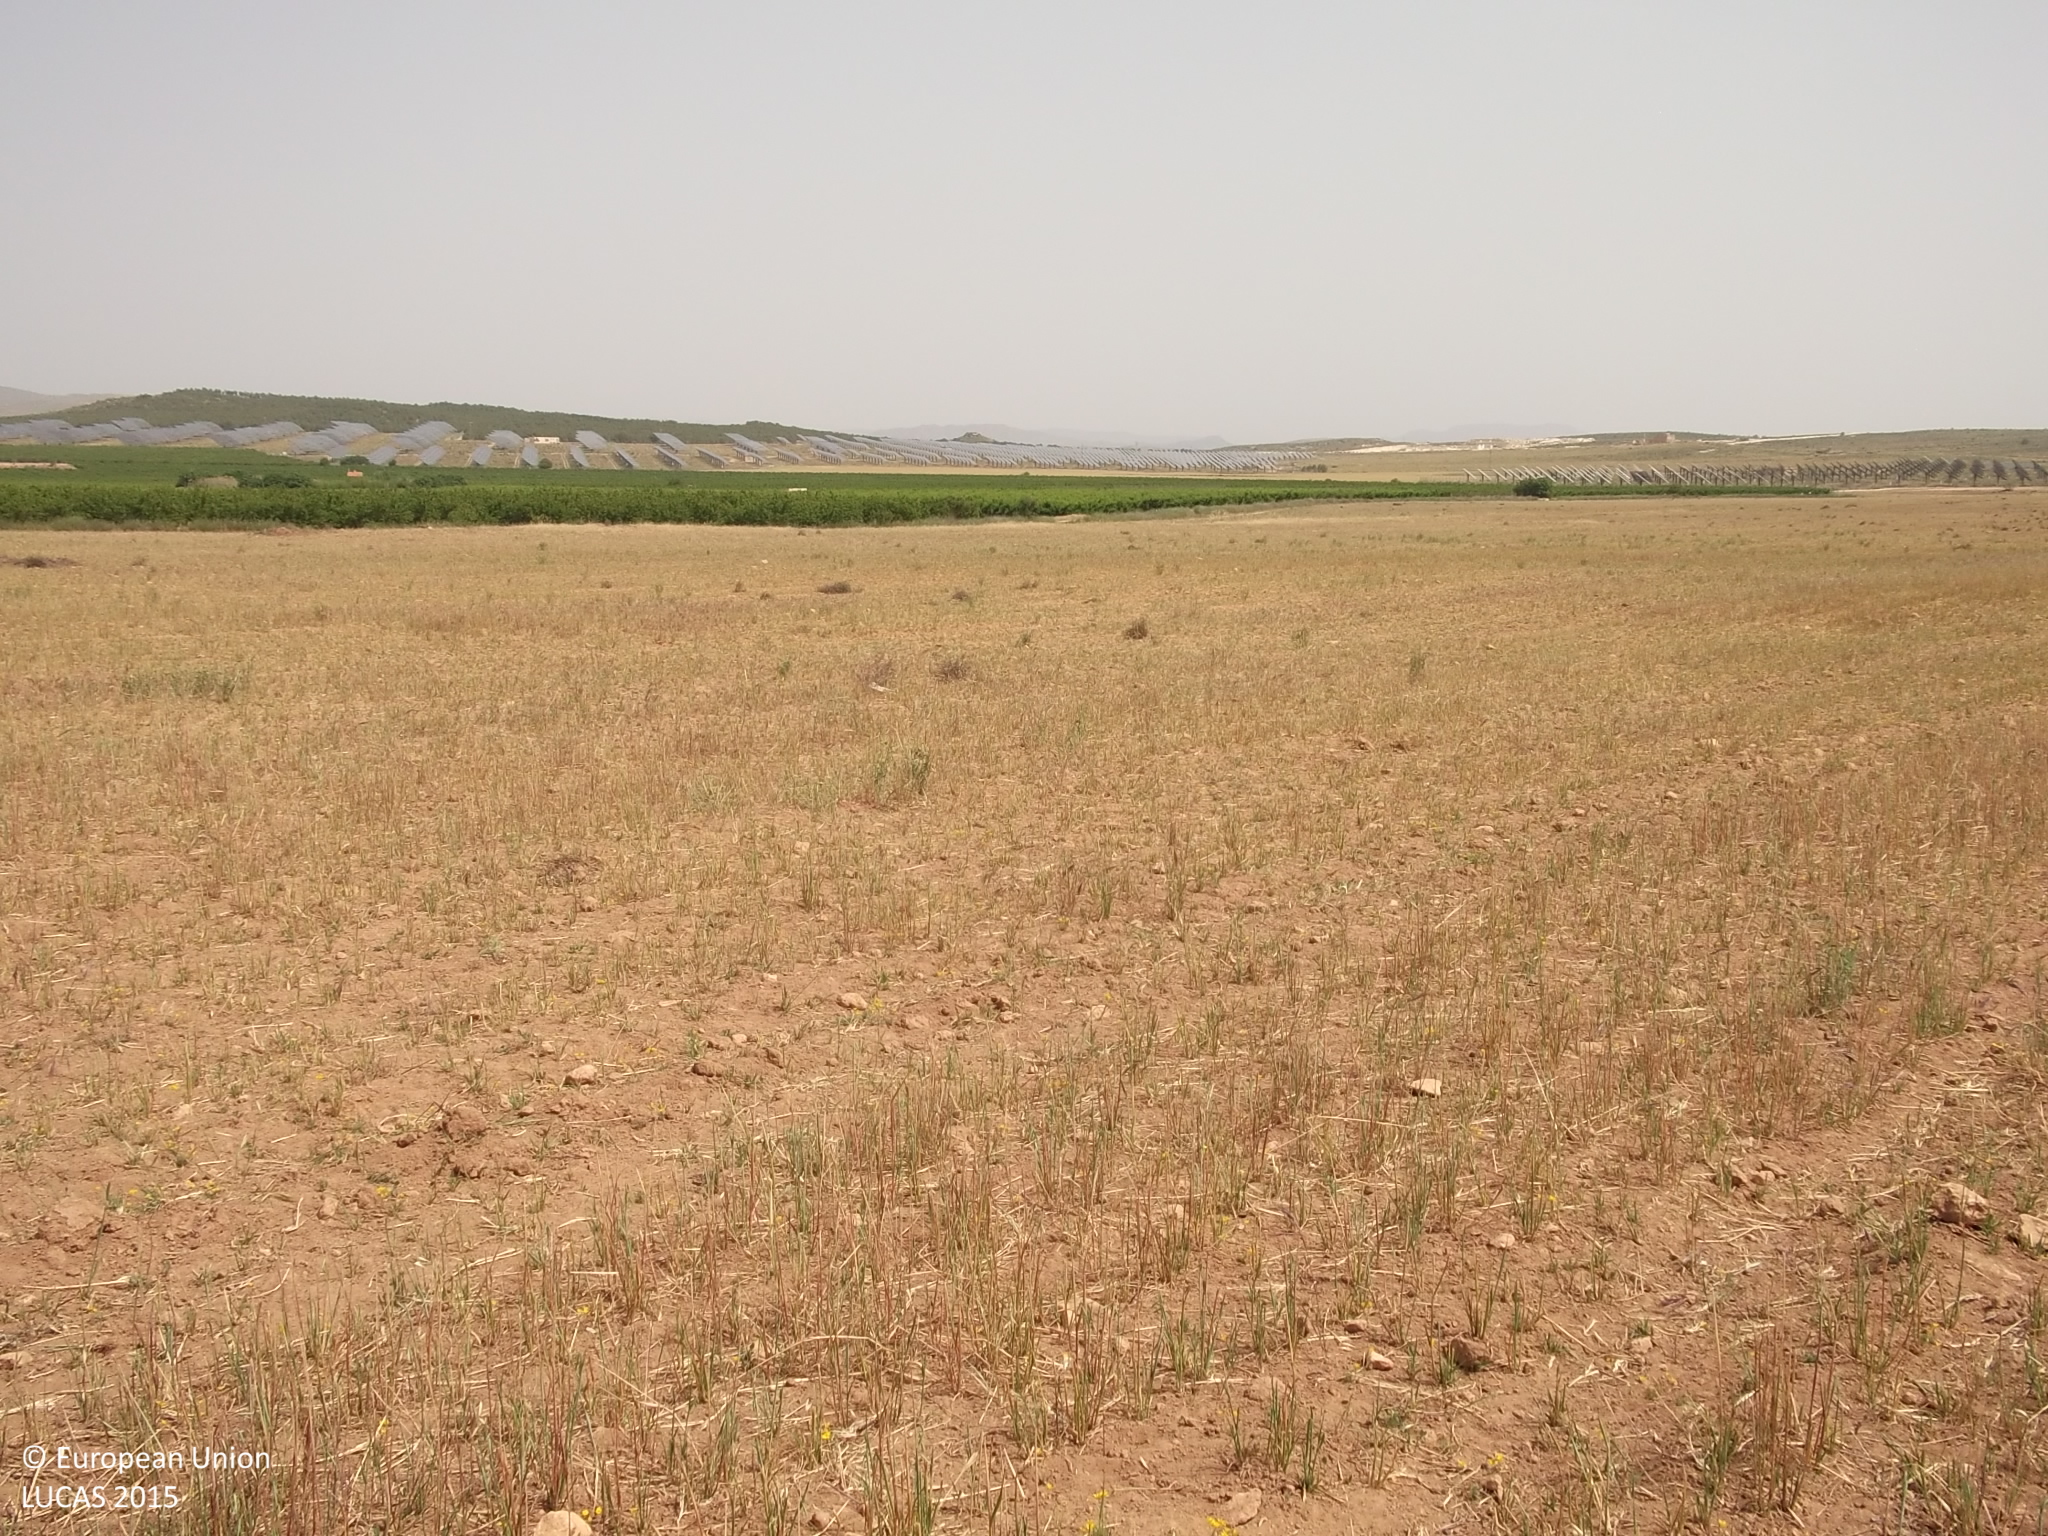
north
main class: Grassland
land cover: Spontaneously vegetated surfaces
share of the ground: 50 - 75 %
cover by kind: herbaceous plants 50 %, unconsolidated bare surface 50 %
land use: Fallow land
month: May
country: ES
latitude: 38.4564
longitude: -1.6466
